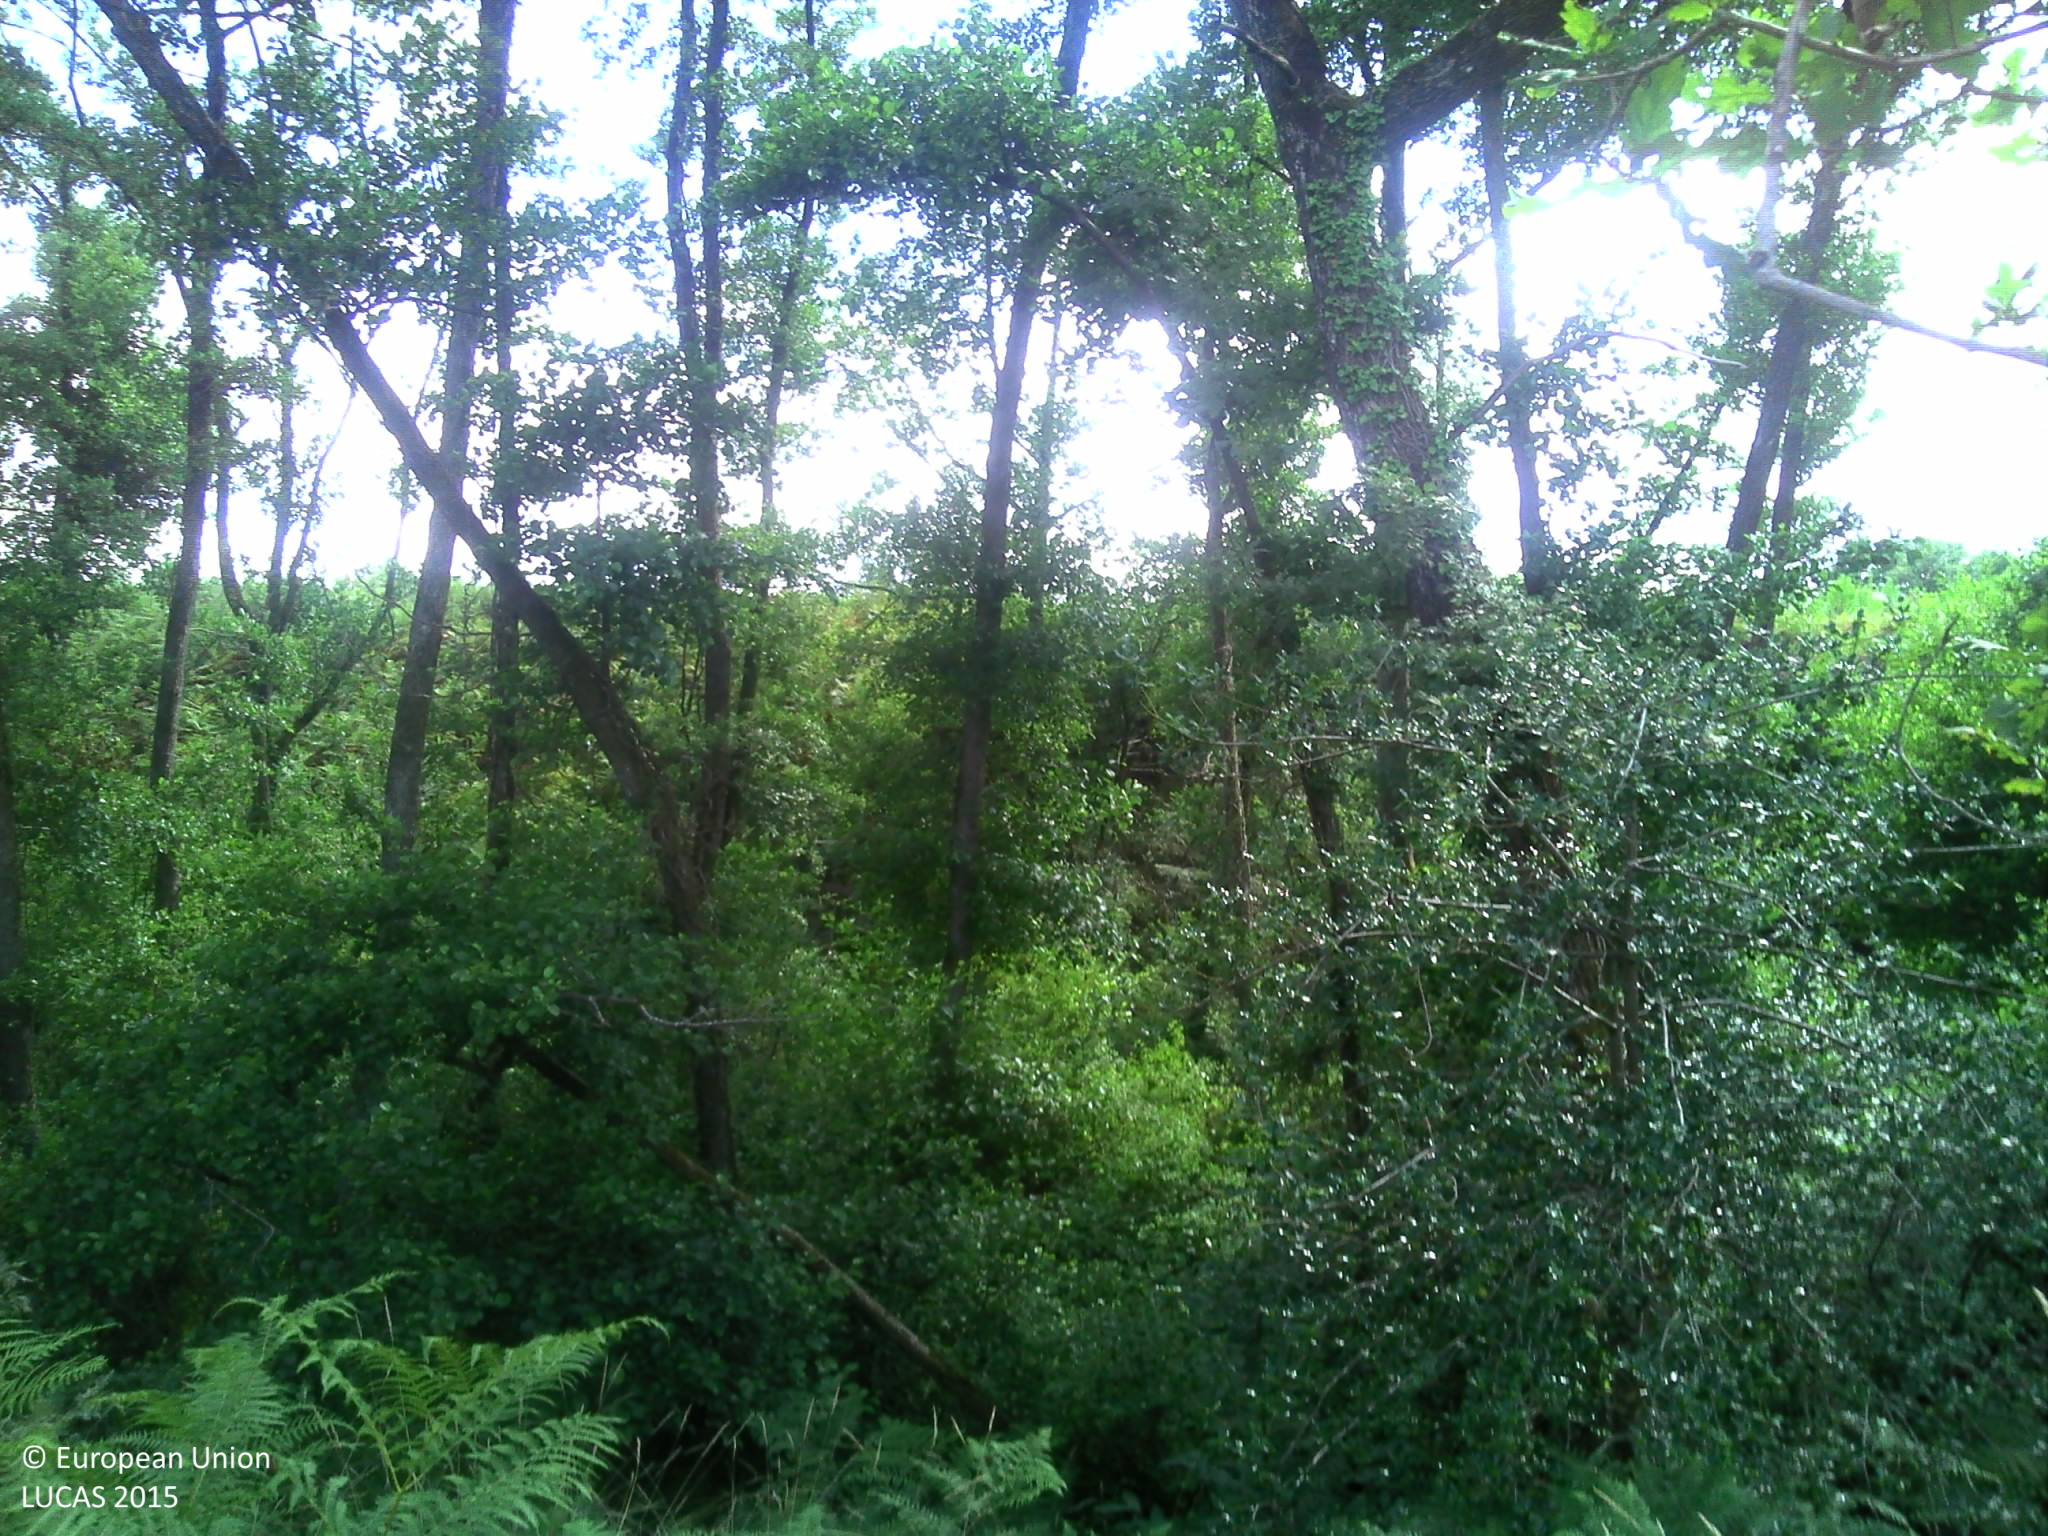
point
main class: Woodland
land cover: Broadleaved woodland
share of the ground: > 75 %
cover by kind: broadleaved forest trees 75 %, shrubs 15 %, herbaceous plants 10 %
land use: Semi-natural and natural areas not in use
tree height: > 5 m
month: July
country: FR
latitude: 44.0057
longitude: -0.7785
